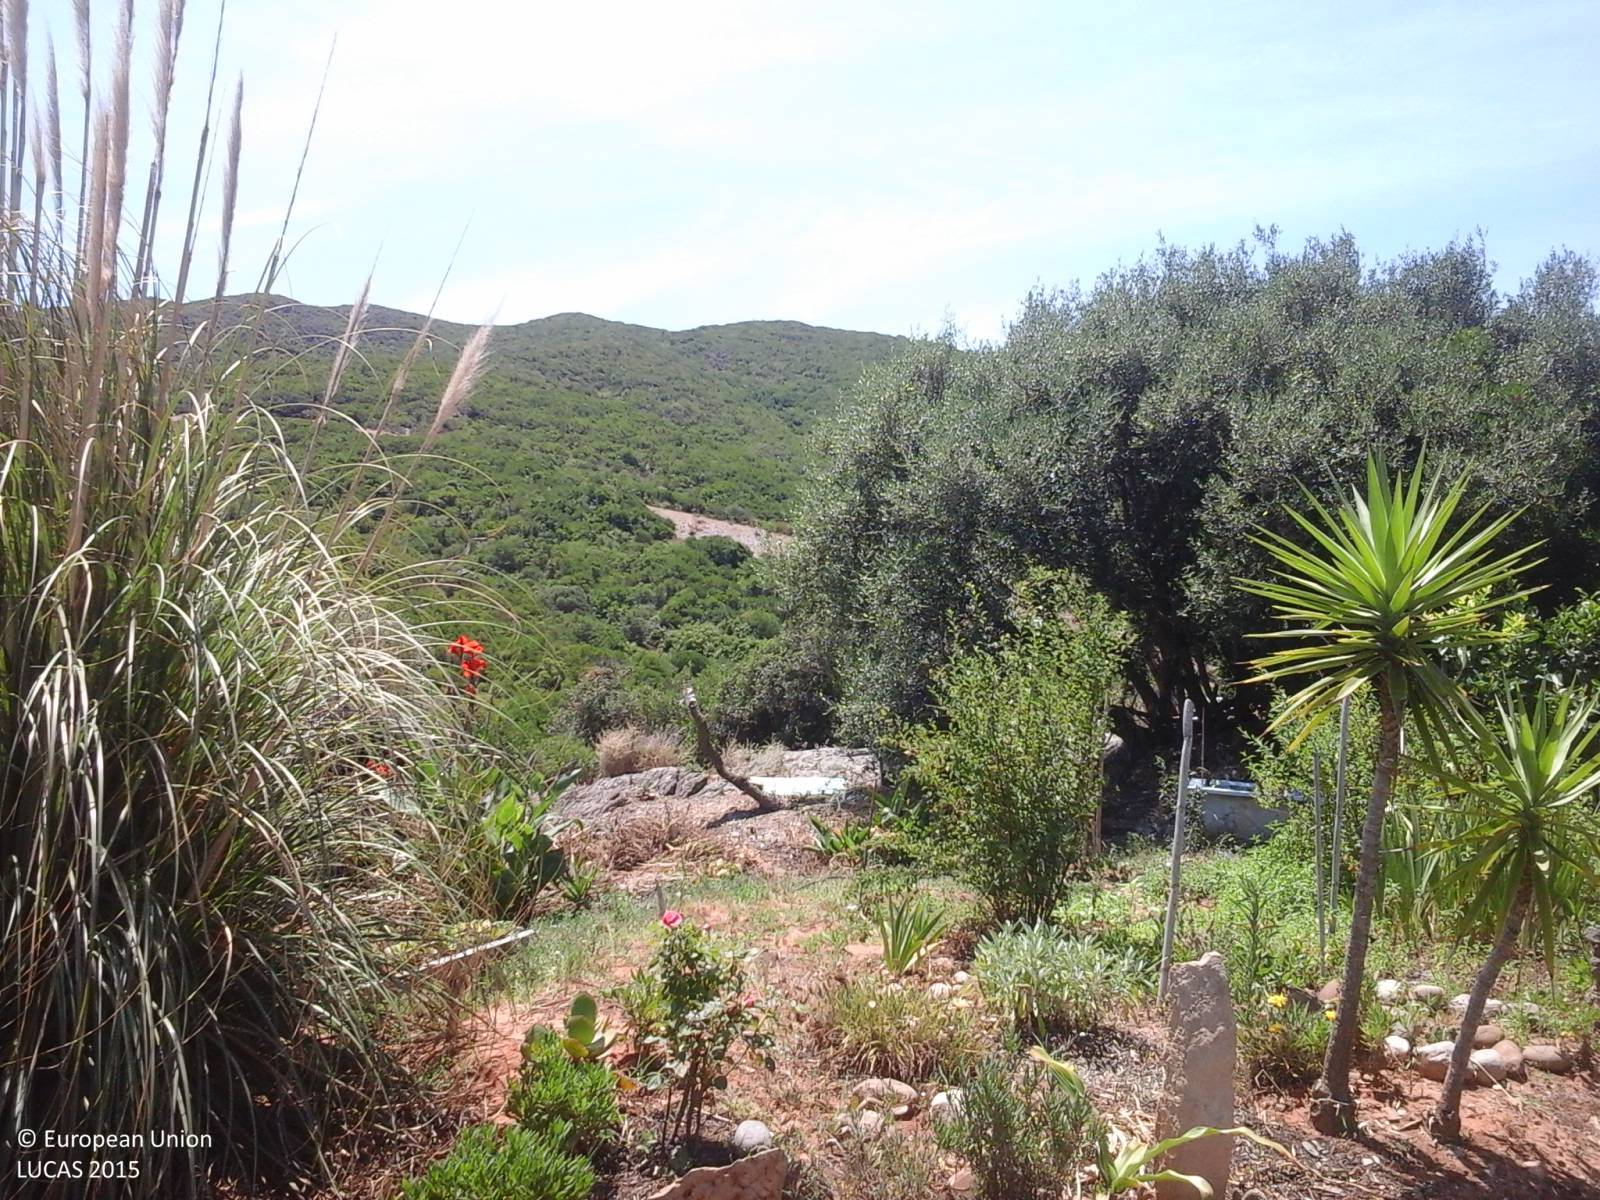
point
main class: Woodland
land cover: Other mixed woodland
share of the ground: 25 - 50 %
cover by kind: herbaceous plants 50 %, broadleaved forest trees 25 %, coniferous forest trees 10 %, unconsolidated bare surface 10 %, shrubs 5 %
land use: Residential
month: June
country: IT
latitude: 39.2242
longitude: 8.5610
